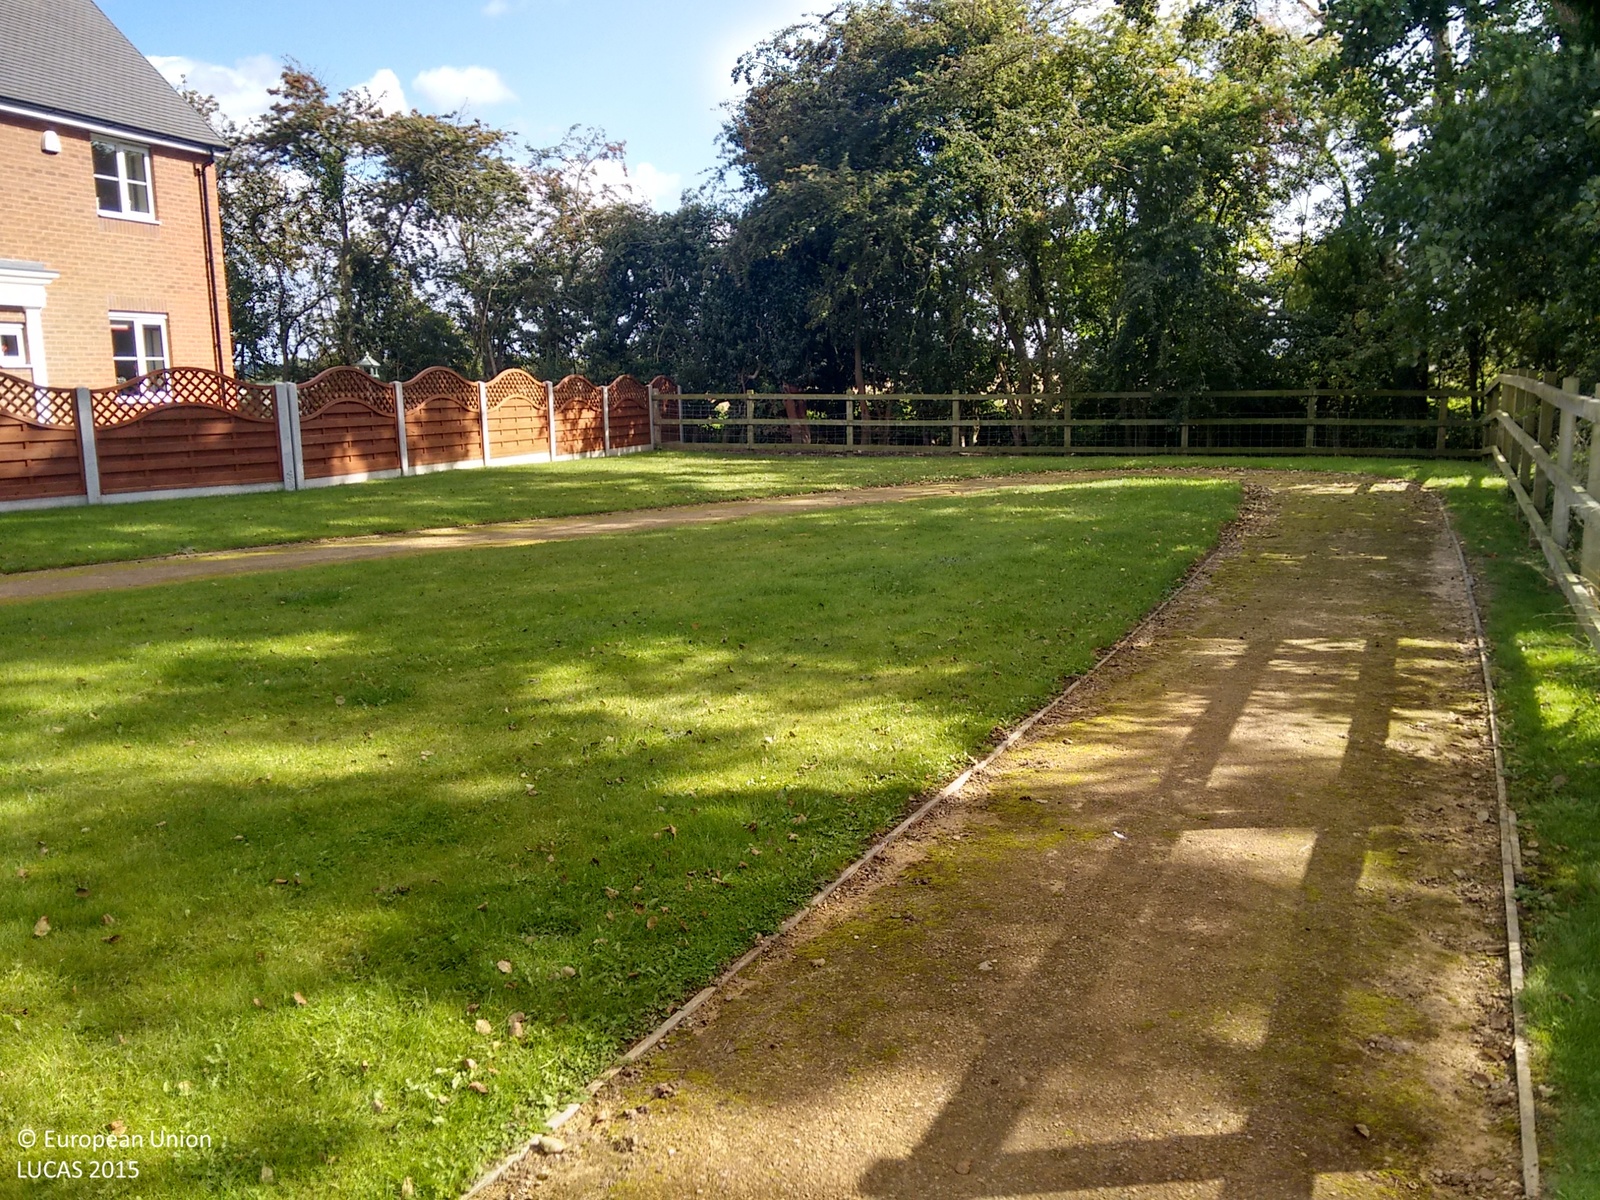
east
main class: Grassland
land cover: Grassland without tree/shrub cover
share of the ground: > 75 %
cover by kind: herbaceous plants 100 %
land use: Agriculture (excluding fallow land and kitchen gardens)
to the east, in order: Grassland without tree/shrub cover; Managed hedges; Tracks; Inland fresh running water; Grass margins; Managed hedges; Common wheat; Abandoned hedges; Common wheat
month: September
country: GB
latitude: 52.8351
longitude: -2.0378
